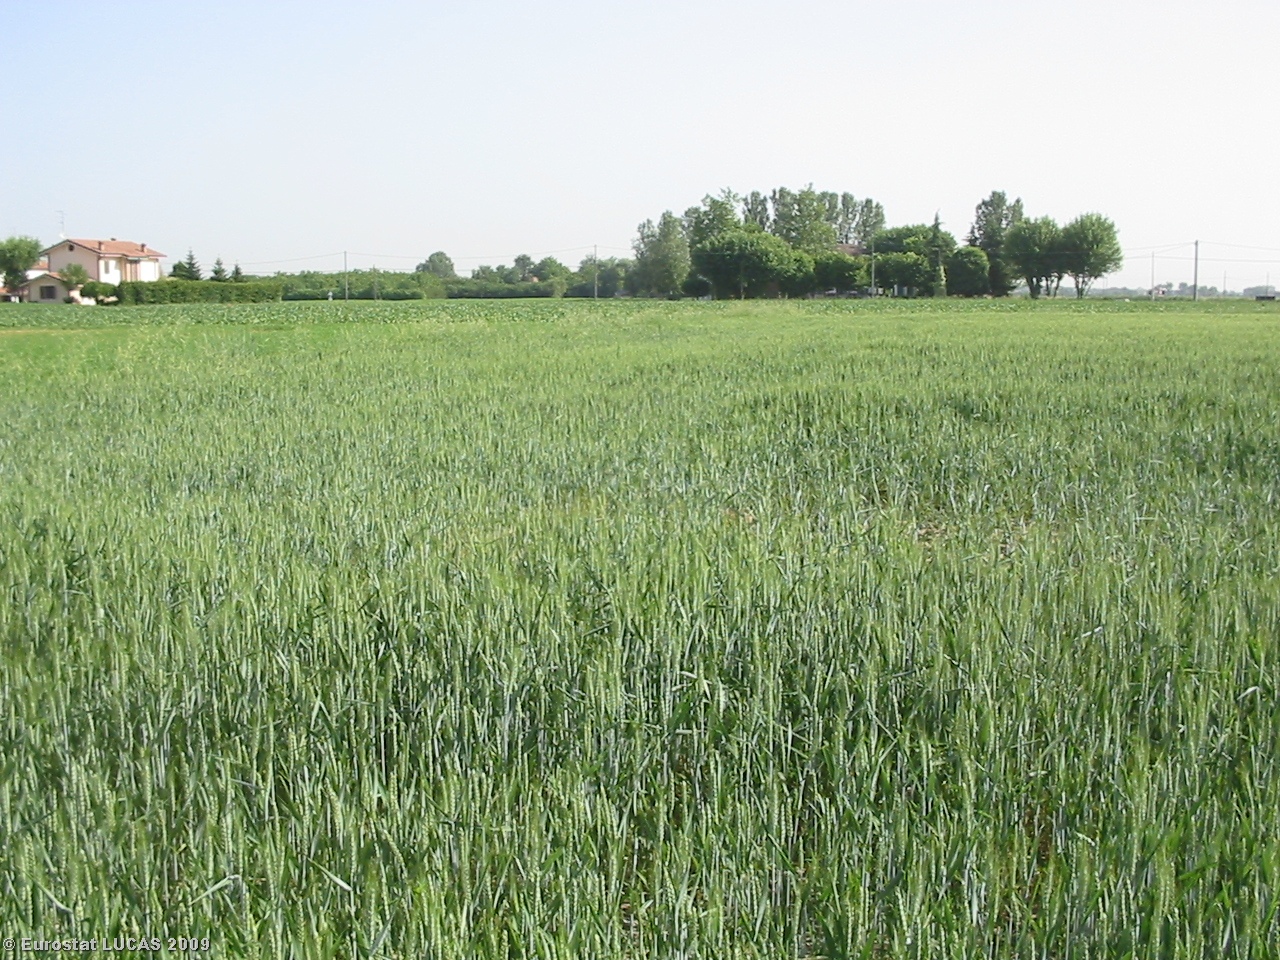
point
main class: Cropland
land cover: Common wheat
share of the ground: > 75 %
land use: Agriculture (excluding fallow land and kitchen gardens)
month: May
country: IT
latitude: 44.8545
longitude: 10.4420
